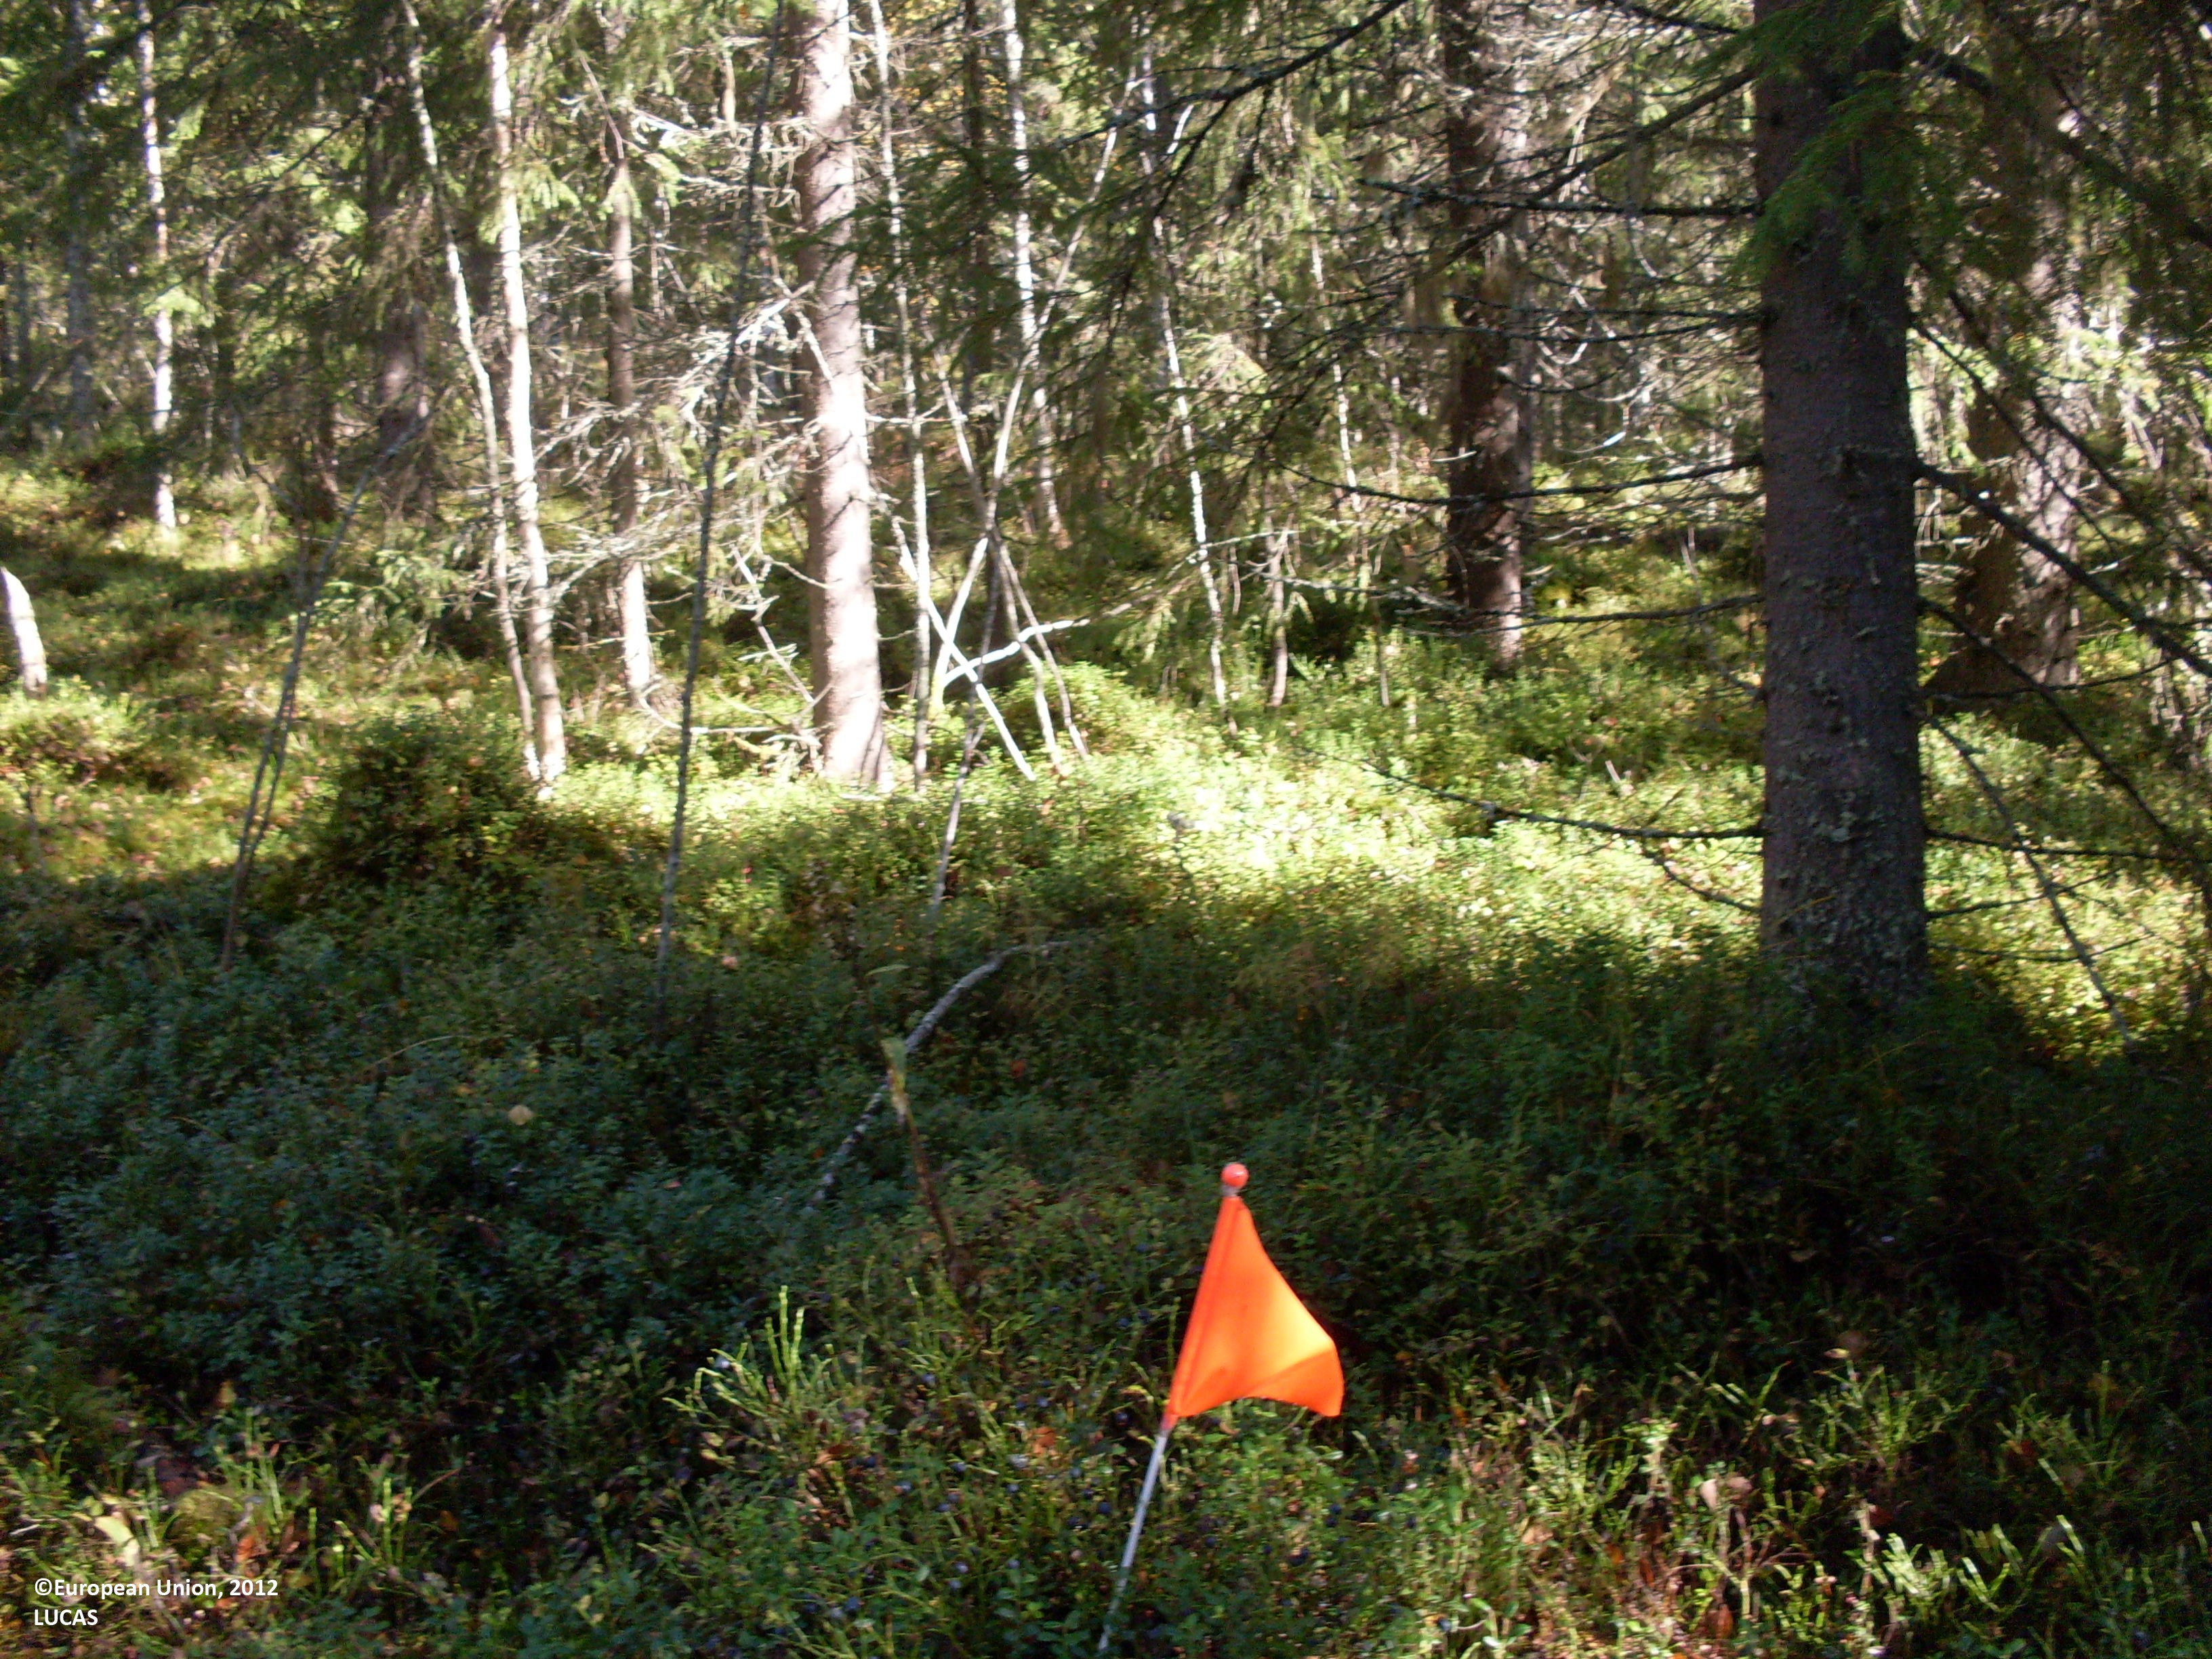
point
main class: Woodland
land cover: Spruce dominated mixed woodland
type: boreal forest
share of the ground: > 75 %
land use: Forestry
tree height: > 5 m
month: September
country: FI
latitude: 64.3326
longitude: 28.4047
